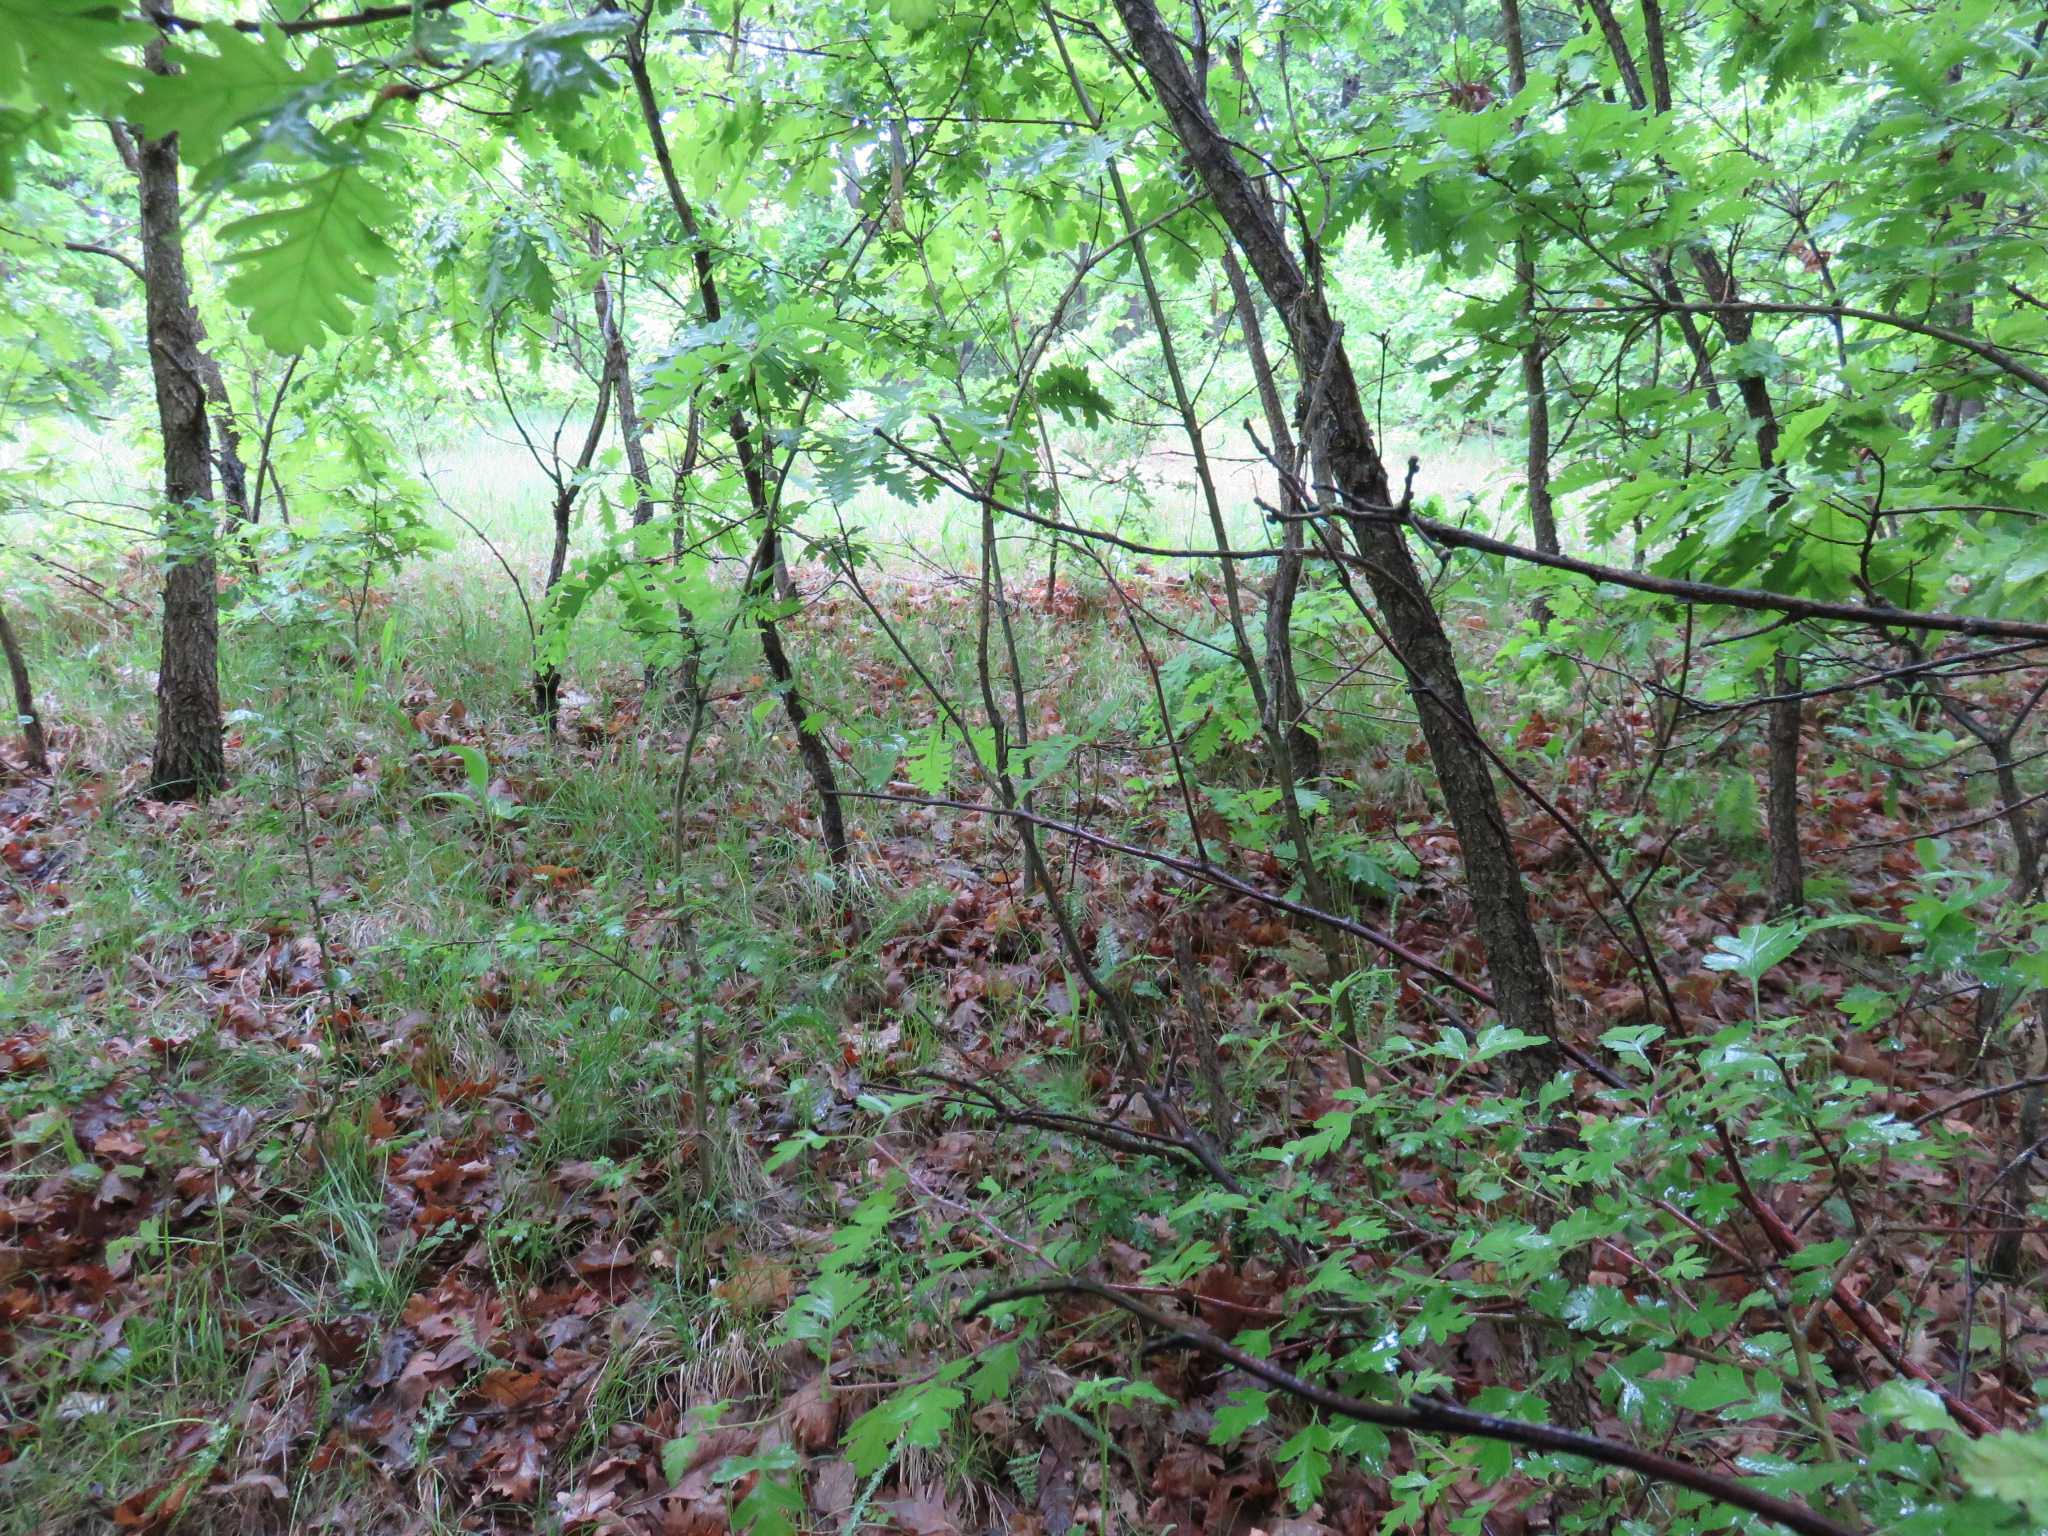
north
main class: Woodland
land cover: Broadleaved woodland
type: mesophytic deciduous forest
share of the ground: > 75 %
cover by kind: broadleaved forest trees 95 %, shrubs 5 %
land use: Forestry
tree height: < 5 m
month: May
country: BG
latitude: 42.9410
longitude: 24.7543
